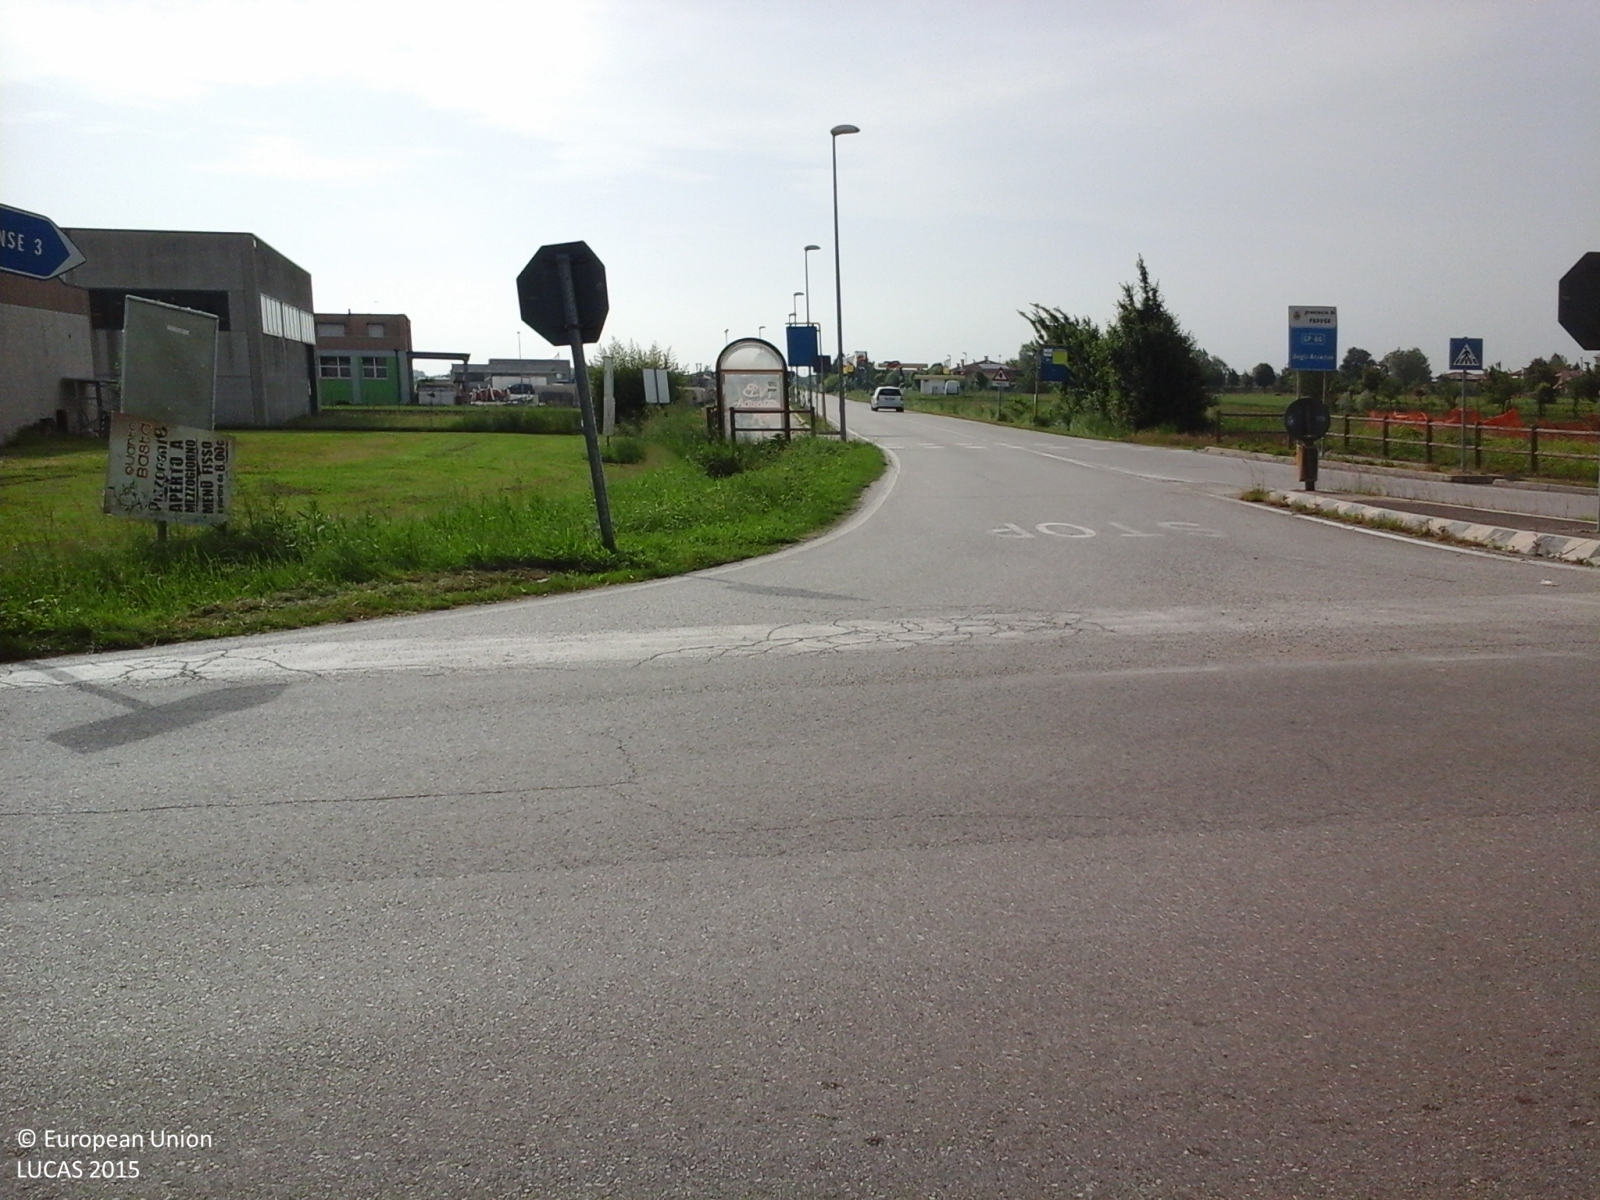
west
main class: Grassland
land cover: Grassland without tree/shrub cover
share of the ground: > 75 %
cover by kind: herbaceous plants 100 %
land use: Agriculture (excluding fallow land and kitchen gardens)
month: May
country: IT
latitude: 45.1480
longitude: 11.7139
